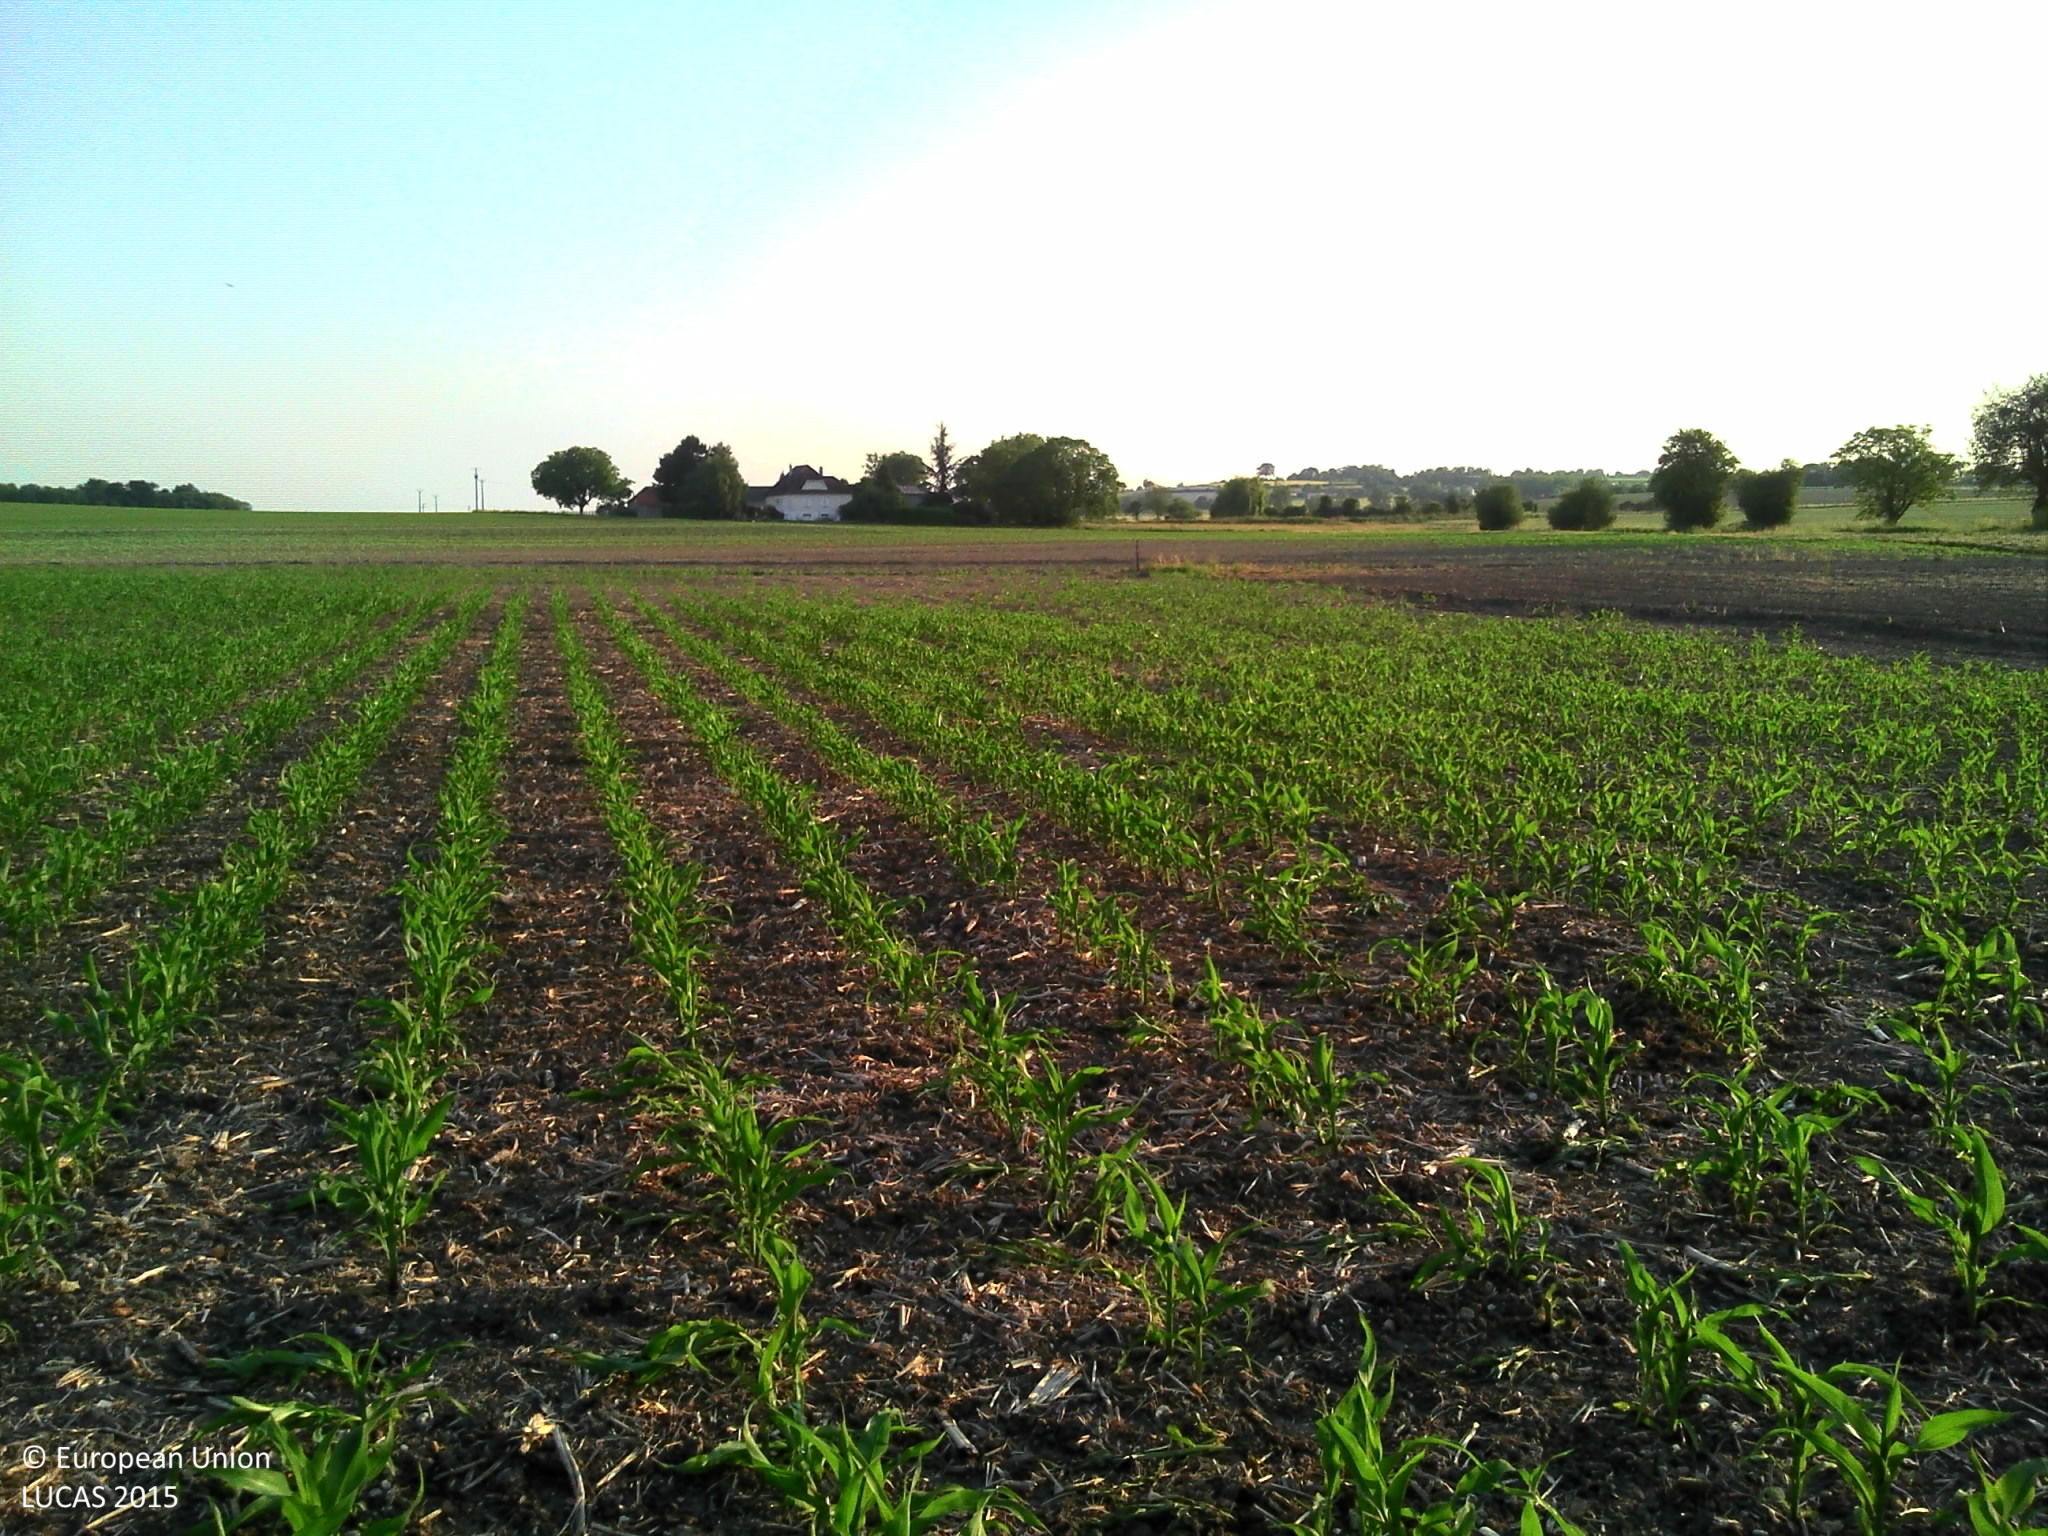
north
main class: Cropland
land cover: Maize
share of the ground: 25 - 50 %
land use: Agriculture (excluding fallow land and kitchen gardens)
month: June
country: FR
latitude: 46.7852
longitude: 0.5639
